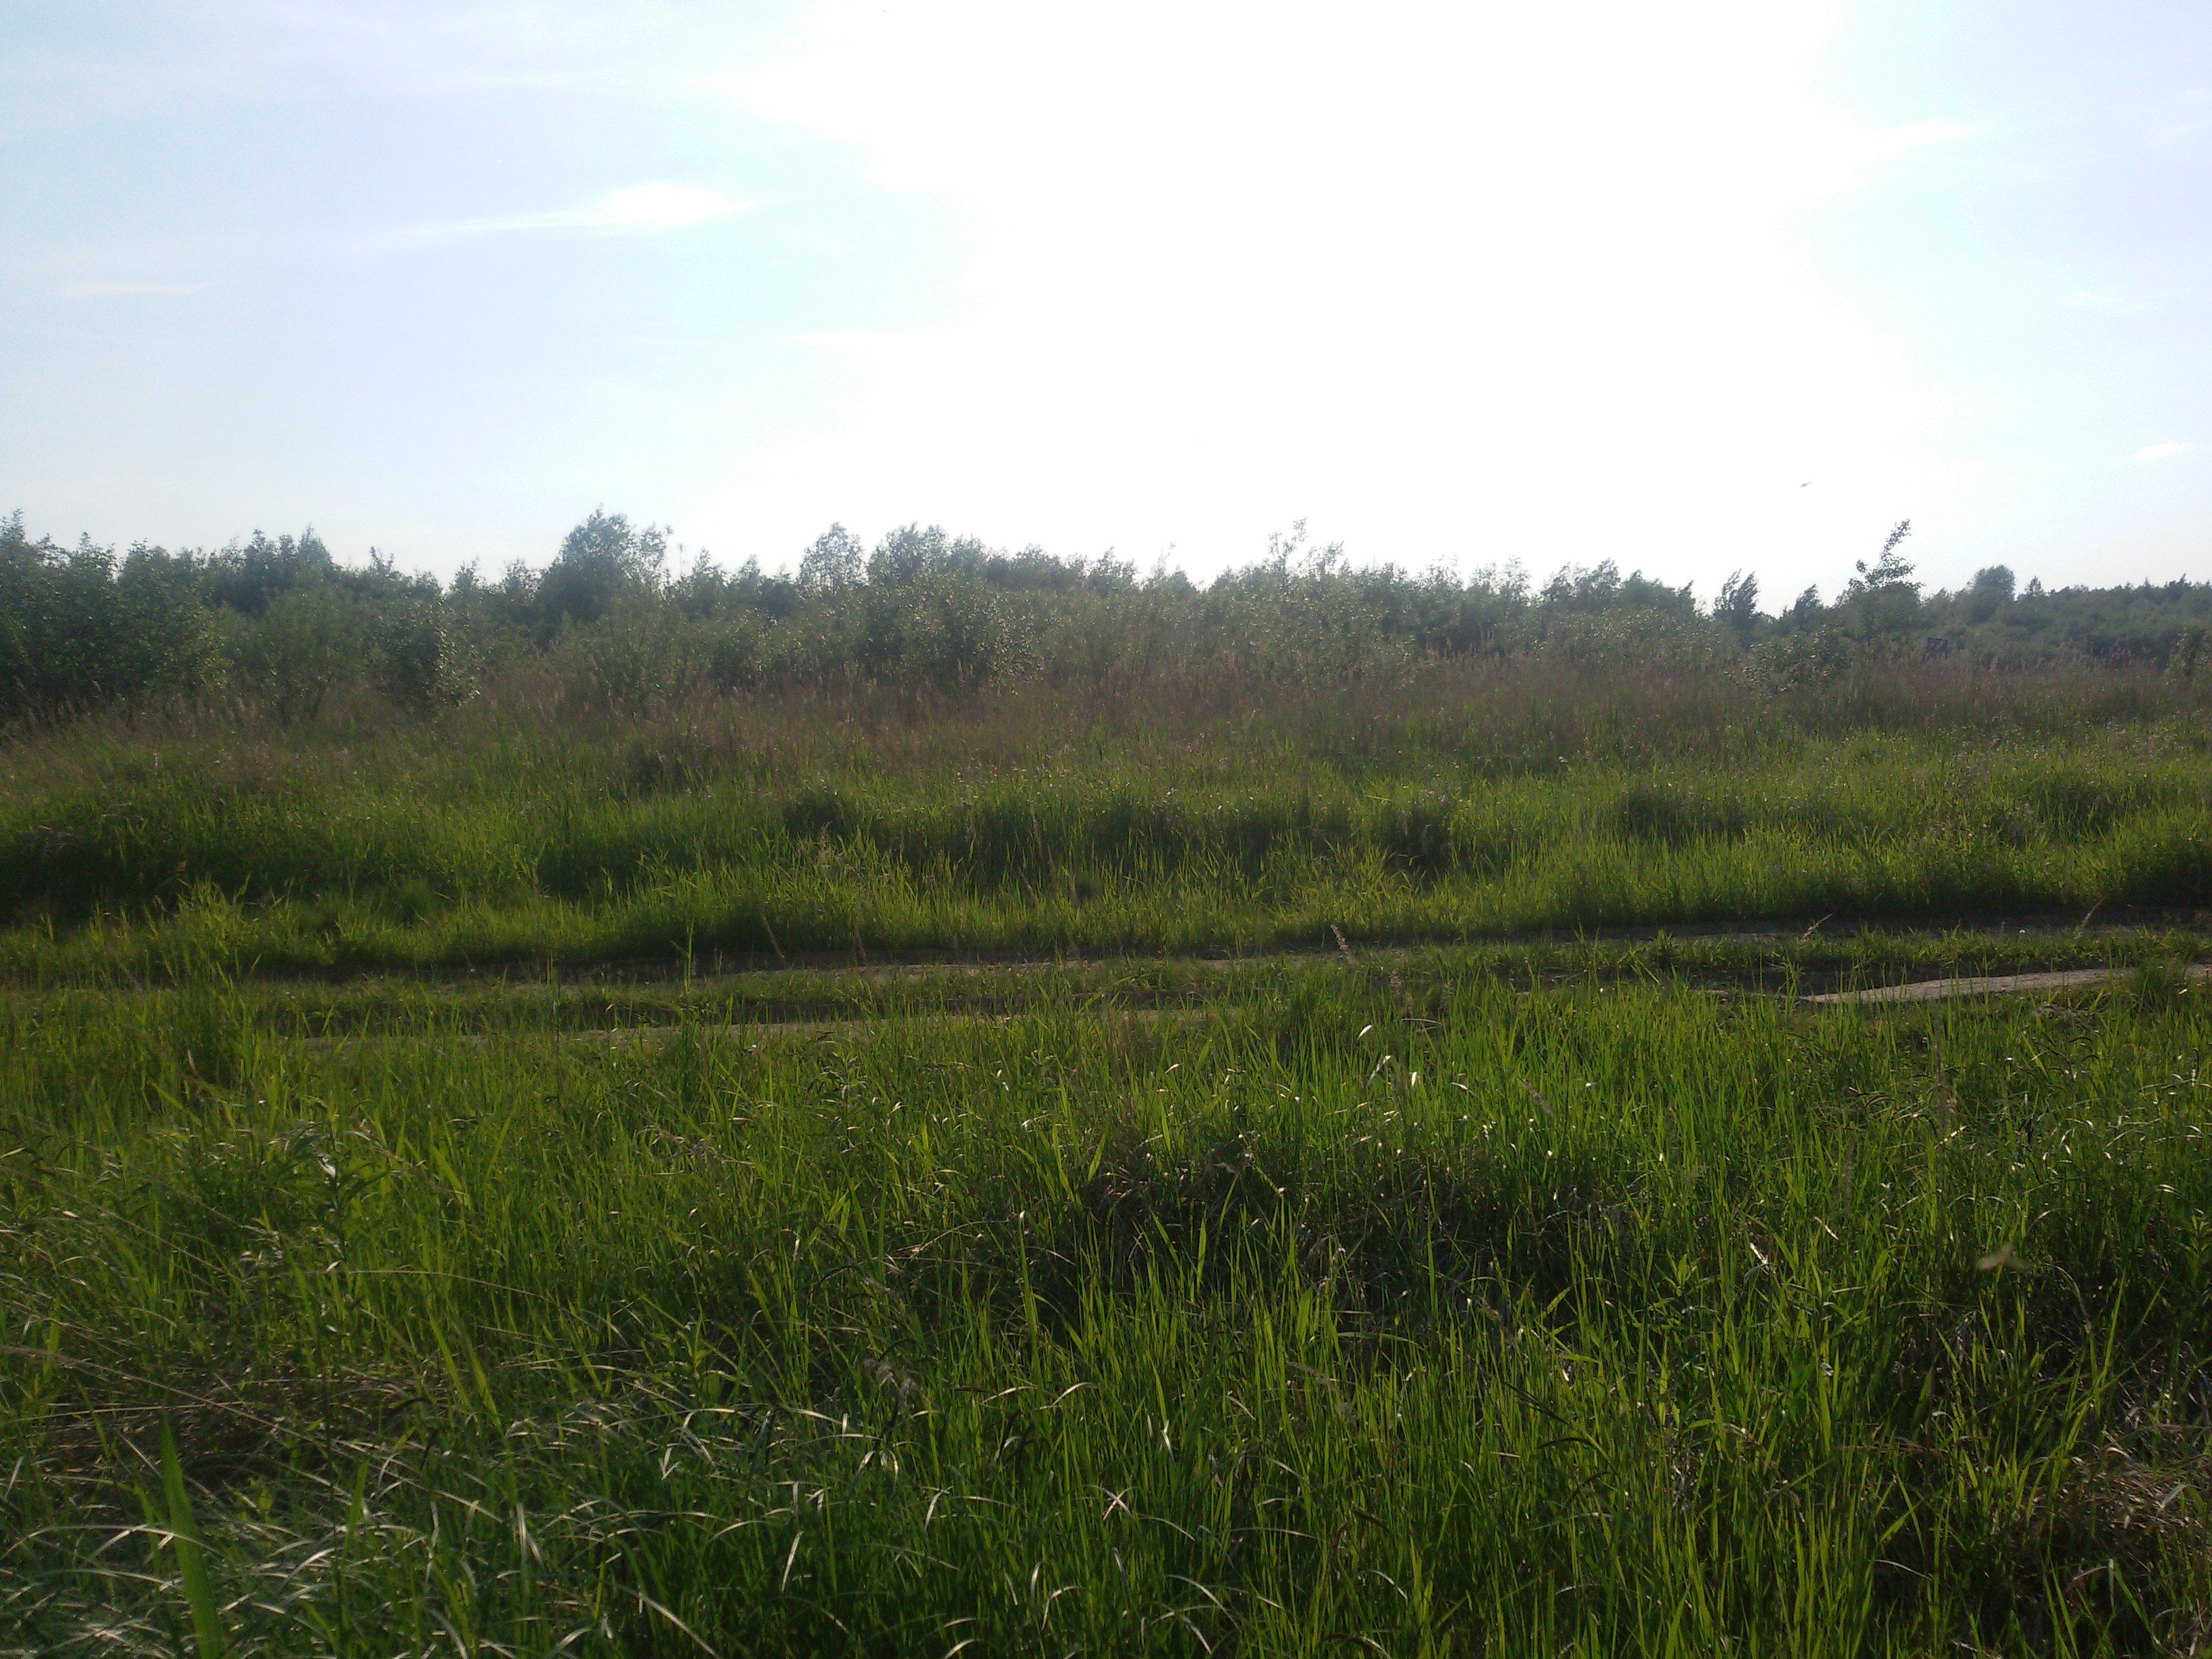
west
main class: Grassland
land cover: Grassland without tree/shrub cover
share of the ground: > 75 %
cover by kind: herbaceous plants 85 %
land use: Semi-natural and natural areas not in use
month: May
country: PL
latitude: 50.4418
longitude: 17.2347
